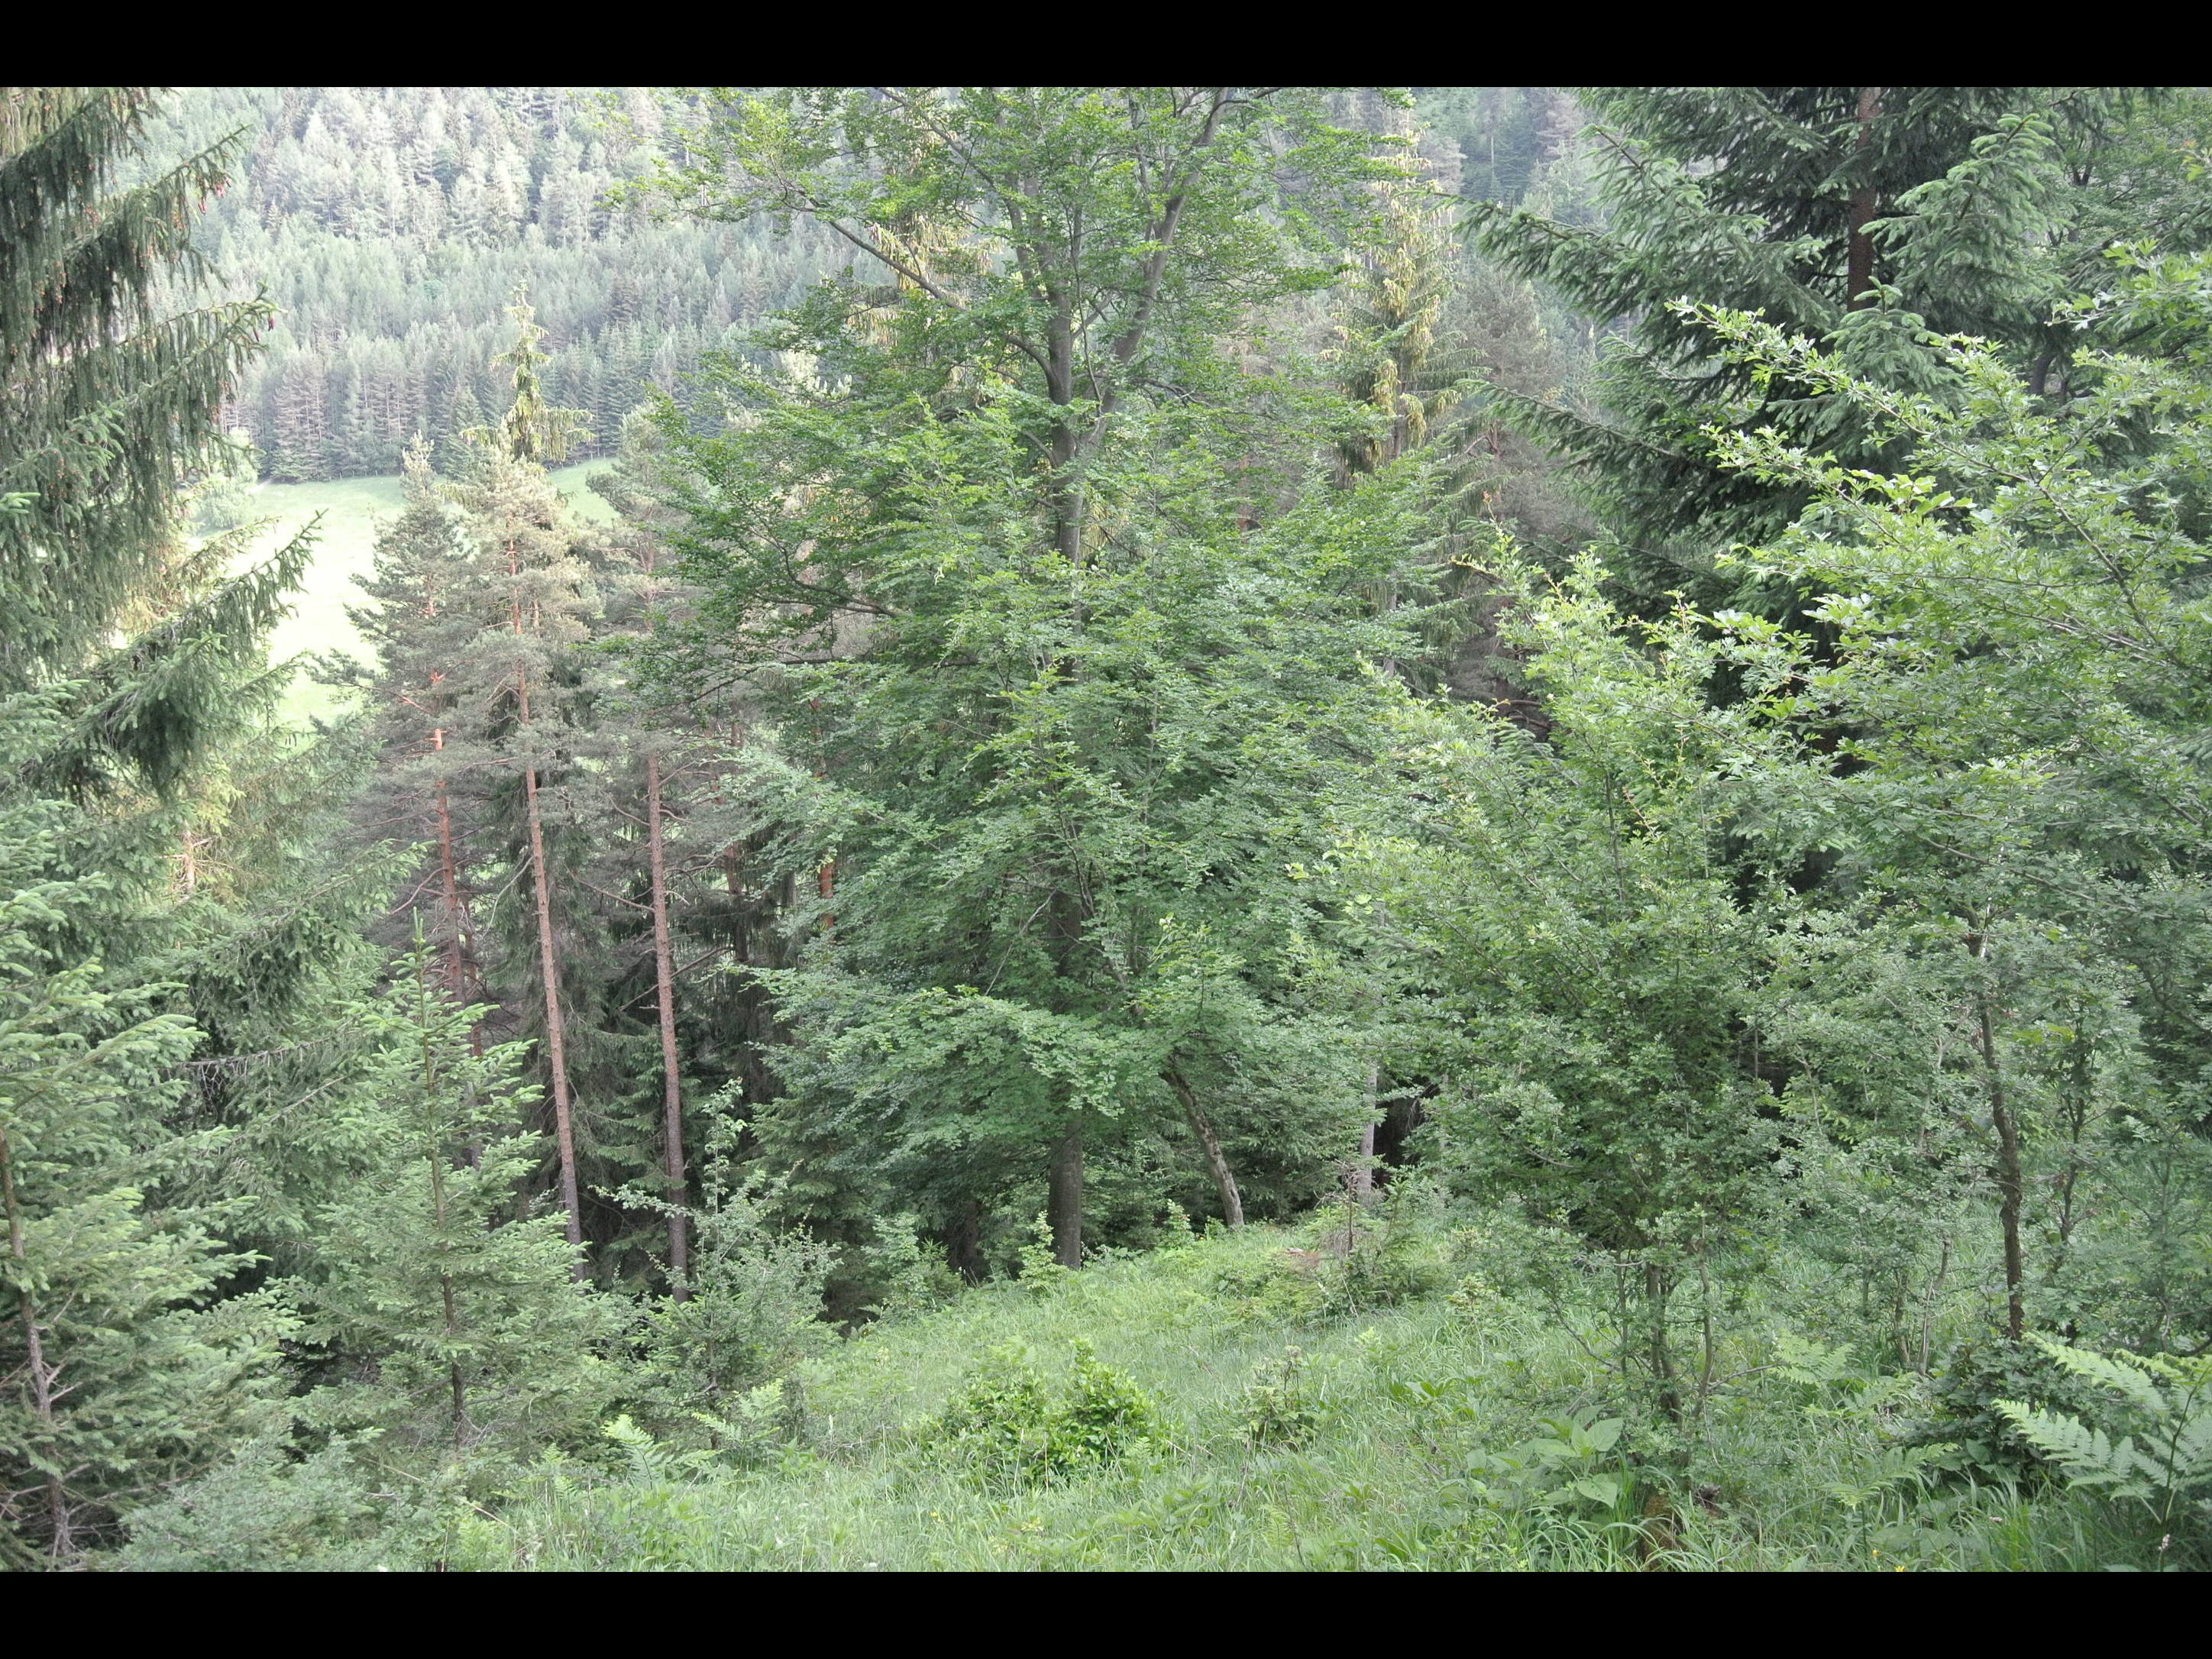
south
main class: Shrubland
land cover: Shrubland with sparse tree cover
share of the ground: > 75 %
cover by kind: herbaceous plants 80 %, shrubs 15 %, coniferous forest trees 5 %
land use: Forestry
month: June
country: AT
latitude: 47.8356
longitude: 15.8142
